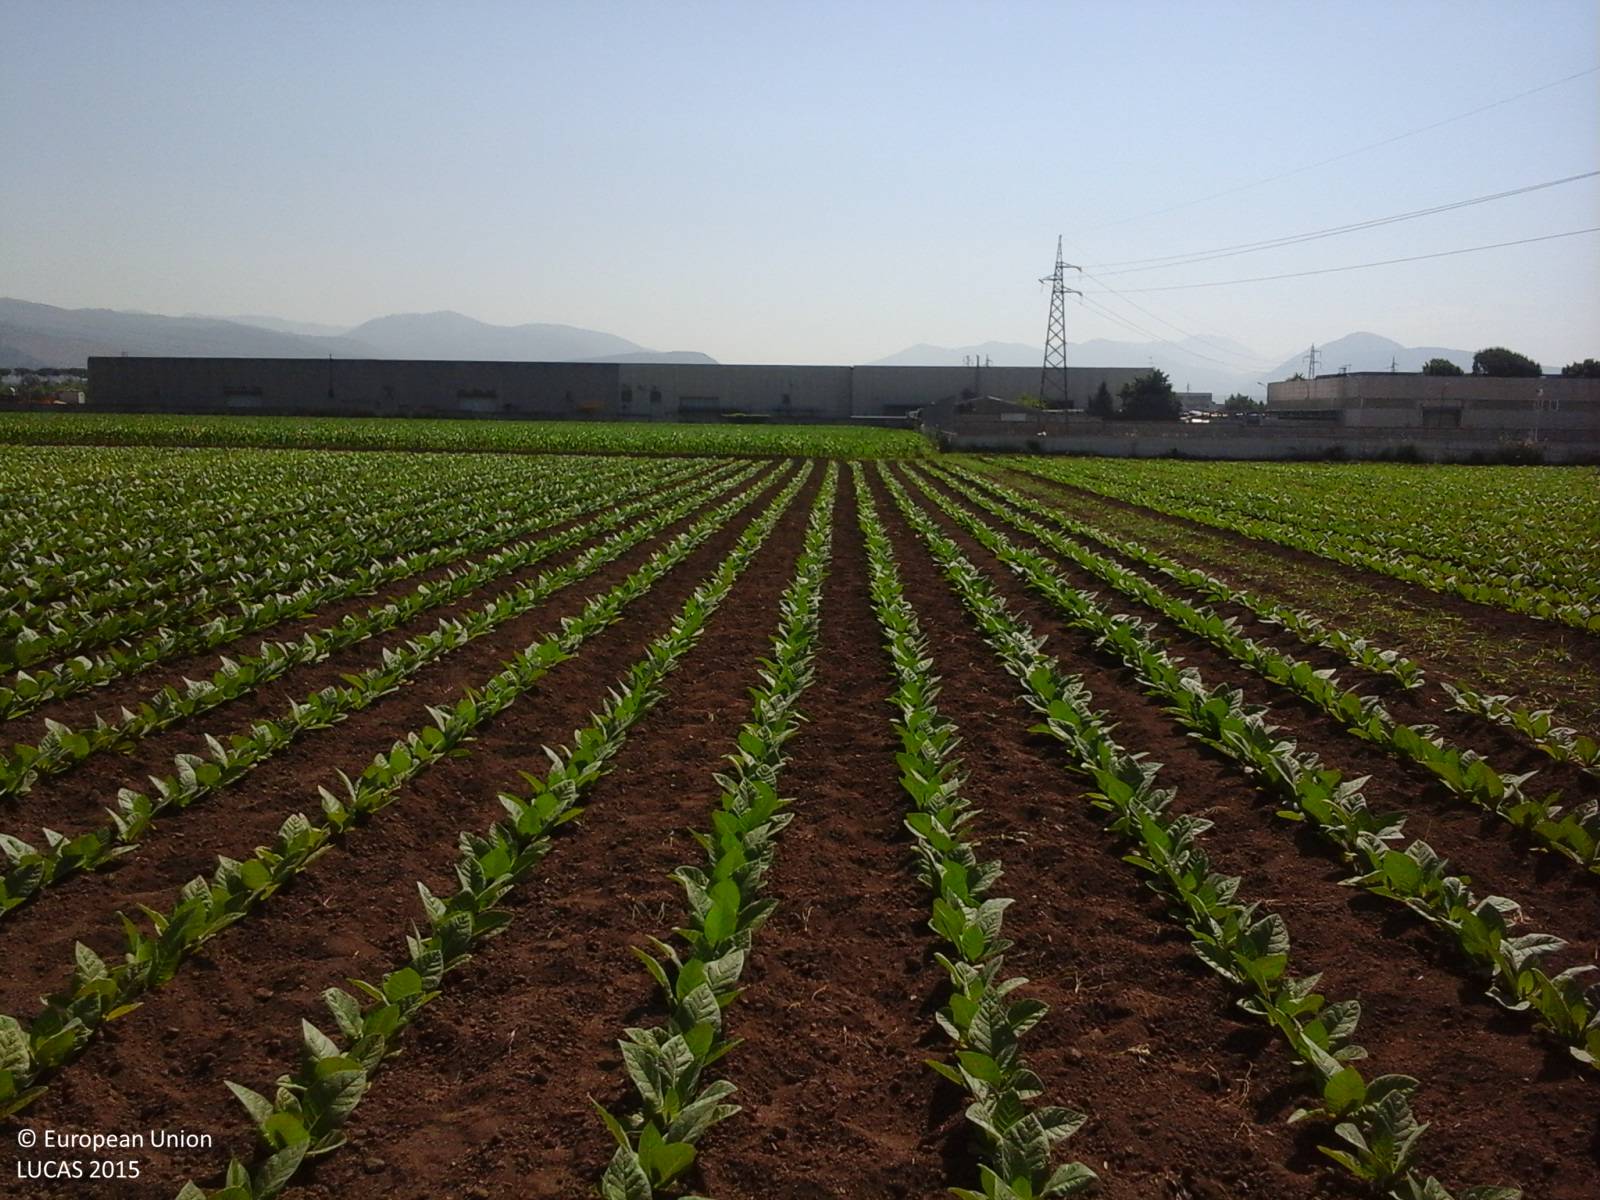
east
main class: Cropland
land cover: Tobacco
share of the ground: 25 - 50 %
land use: Agriculture (excluding fallow land and kitchen gardens)
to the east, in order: Tobacco; Grass margins; Maize; Grass margins; Artificial constructions in urban areas; Grass margins; Potatoes
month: June
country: IT
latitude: 41.0225
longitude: 14.3471
